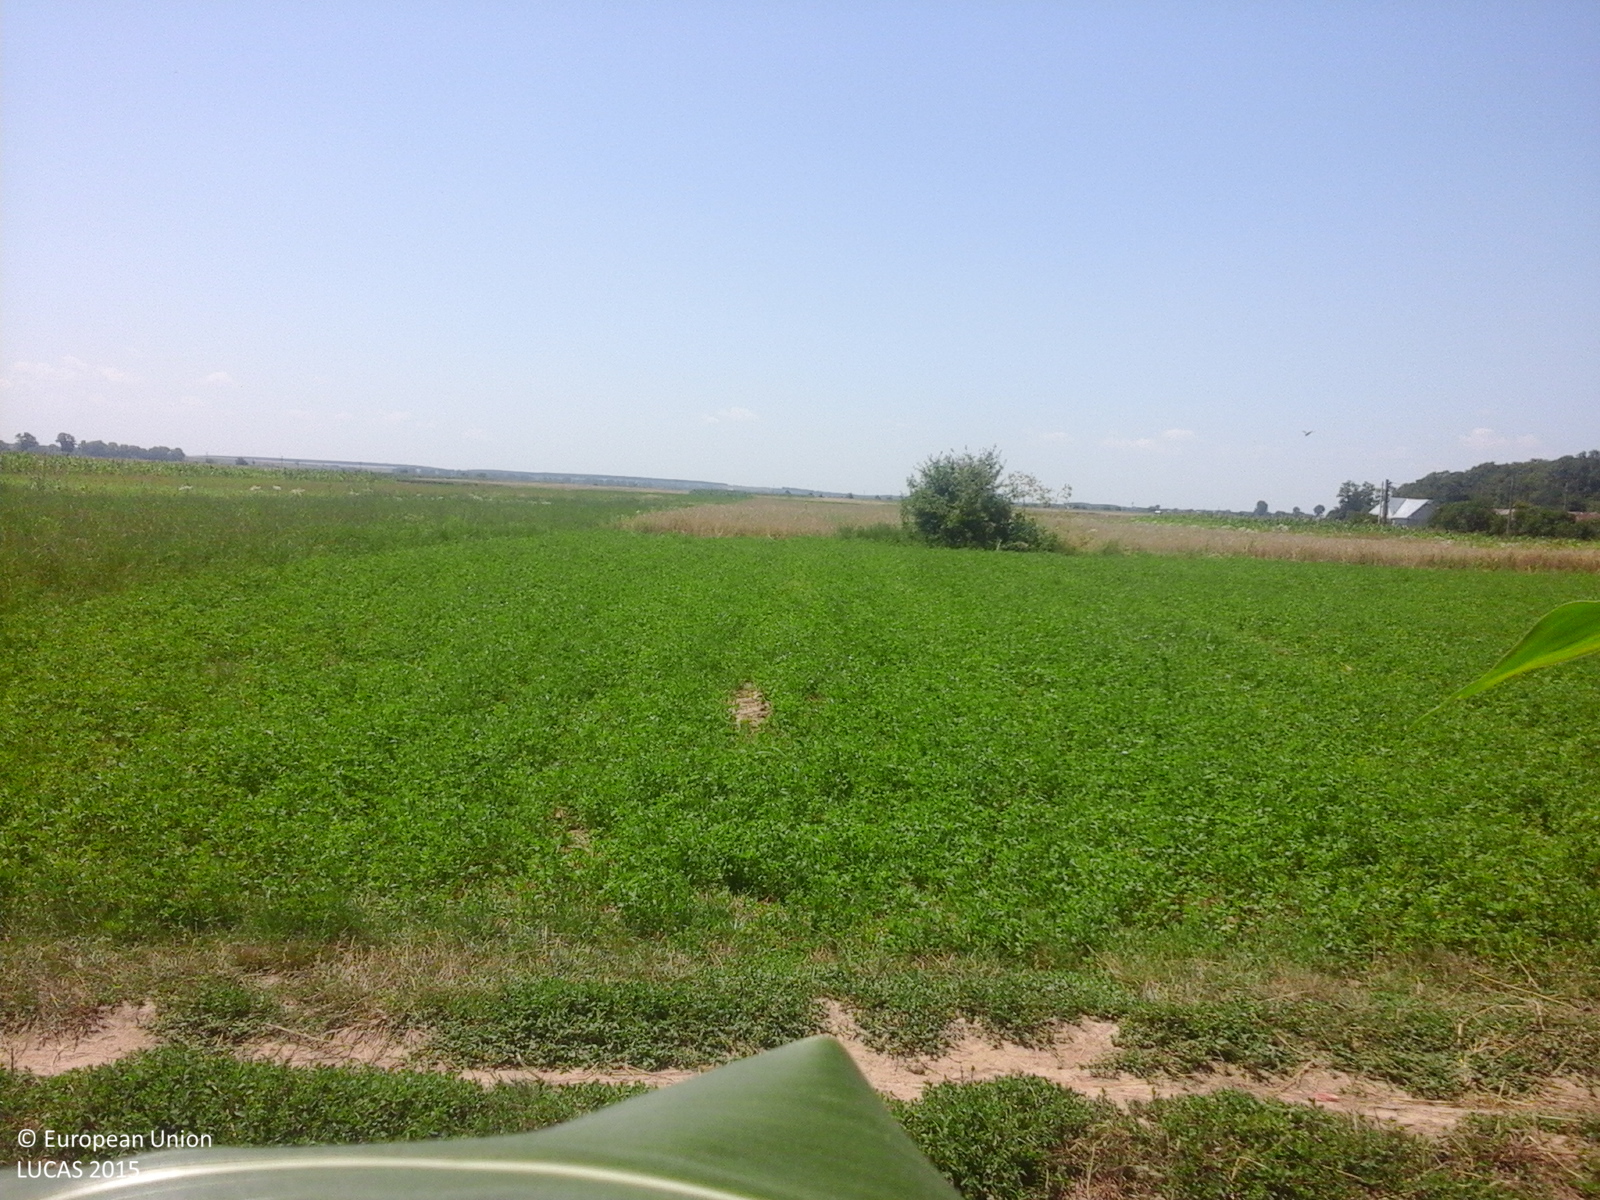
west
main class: Cropland
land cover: Maize
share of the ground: > 75 %
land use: Agriculture (excluding fallow land and kitchen gardens)
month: July
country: RO
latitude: 44.2431
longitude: 24.3537
